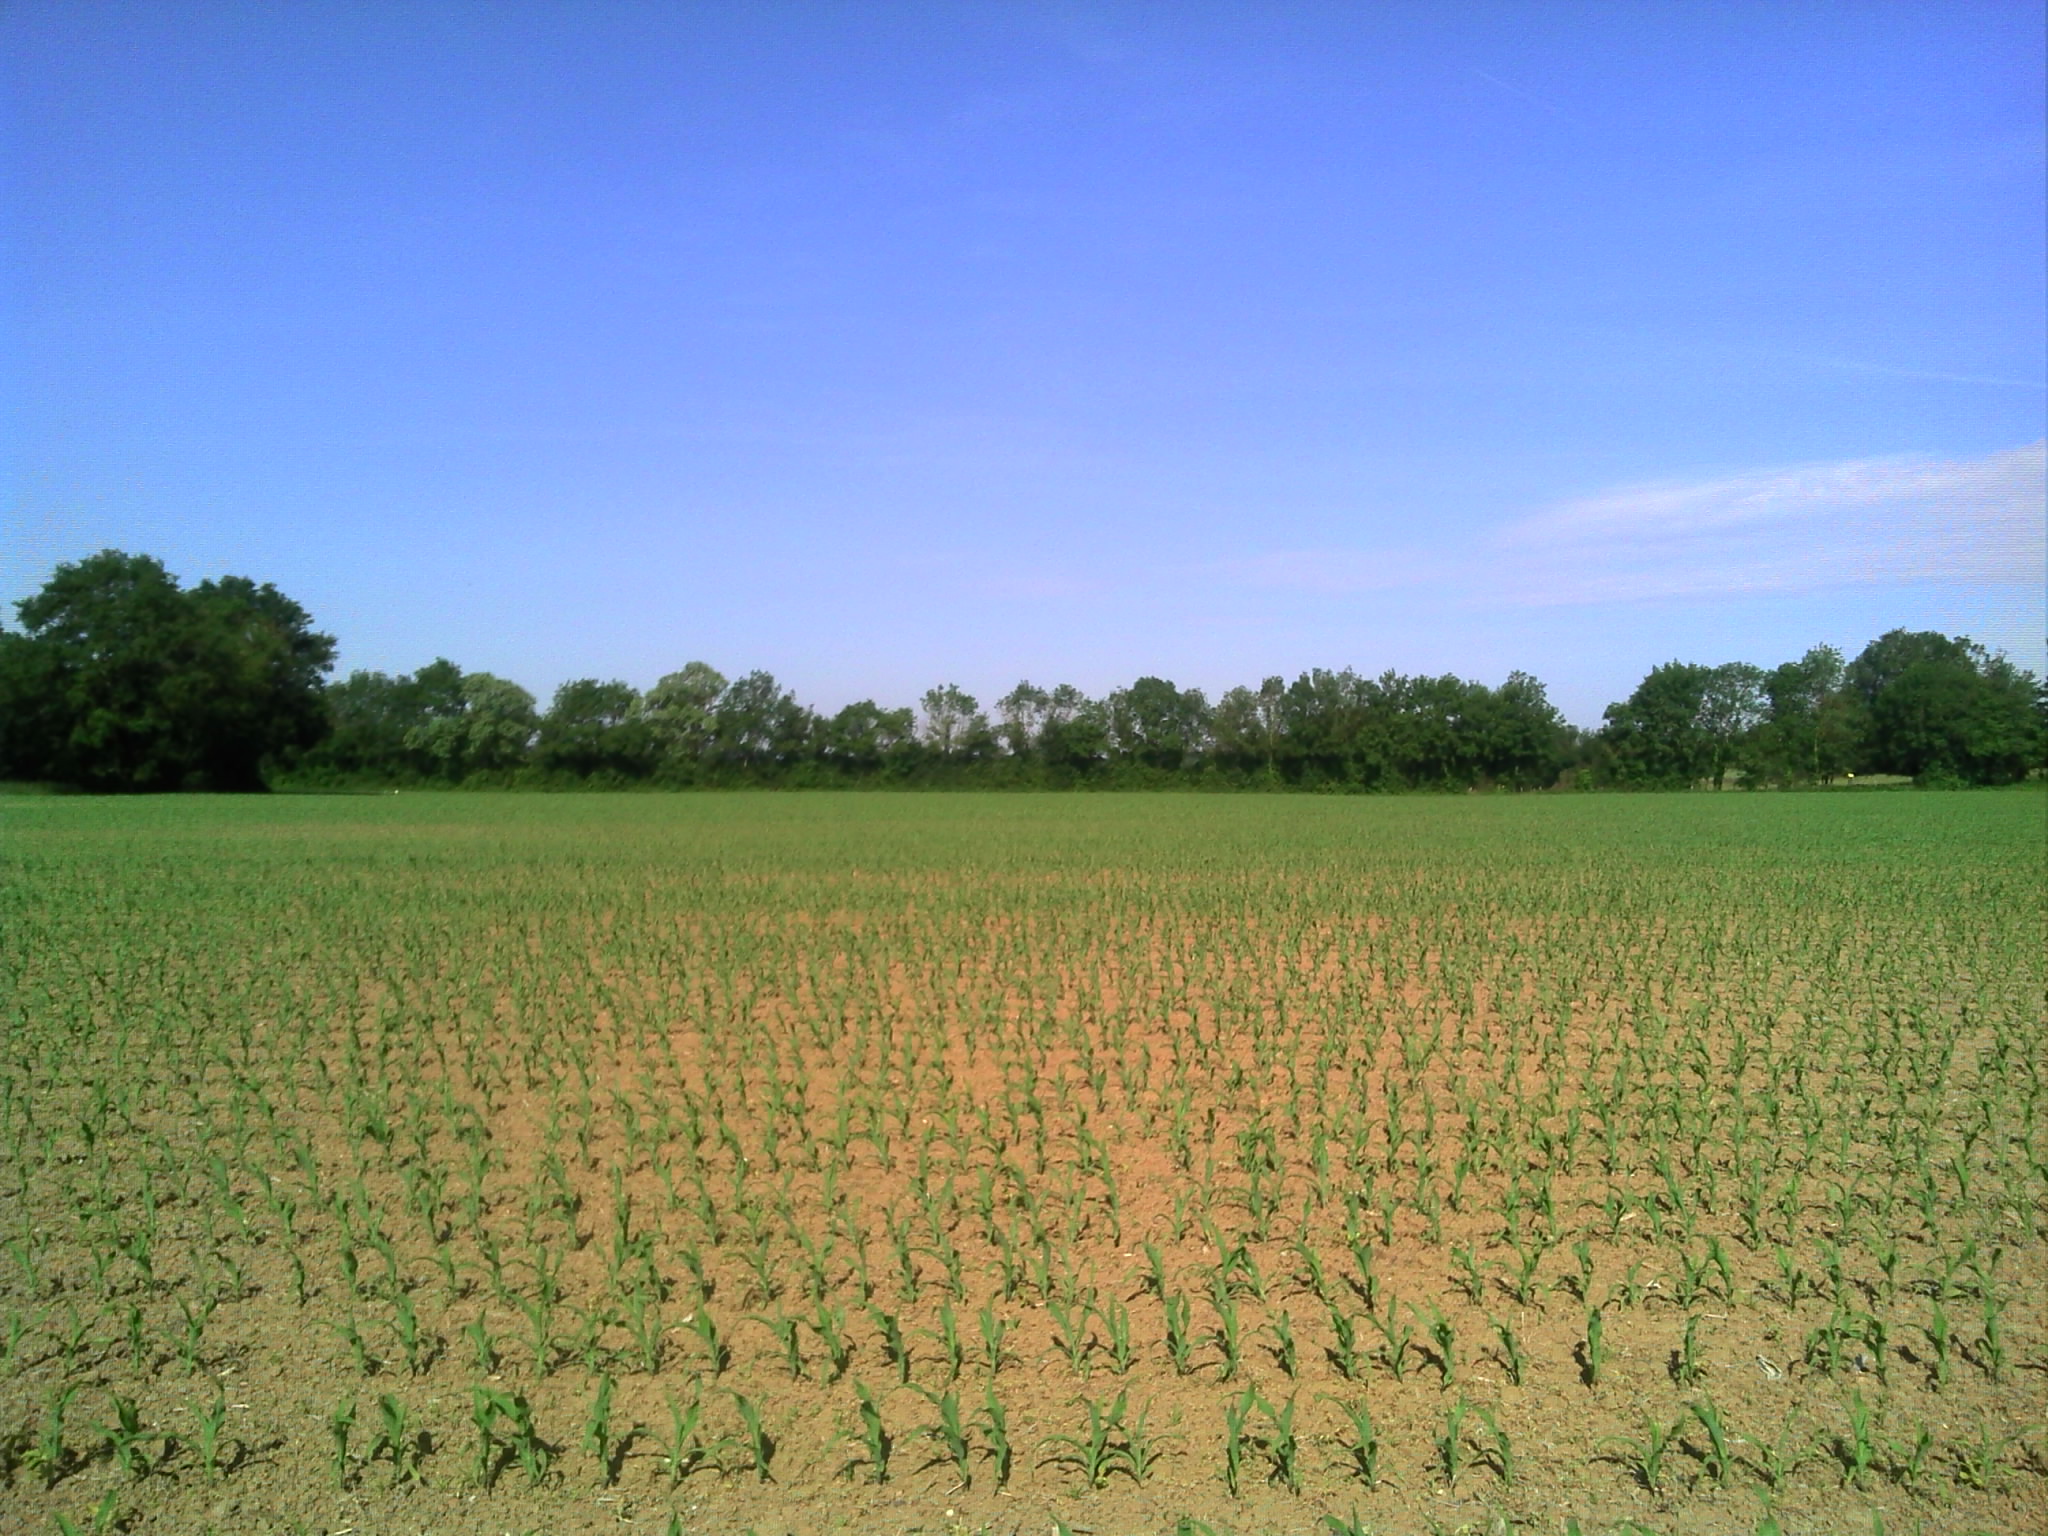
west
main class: Cropland
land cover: Maize
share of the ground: 10 - 25 %
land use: Agriculture (excluding fallow land and kitchen gardens)
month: May
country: FR
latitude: 46.6181
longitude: 5.1050
